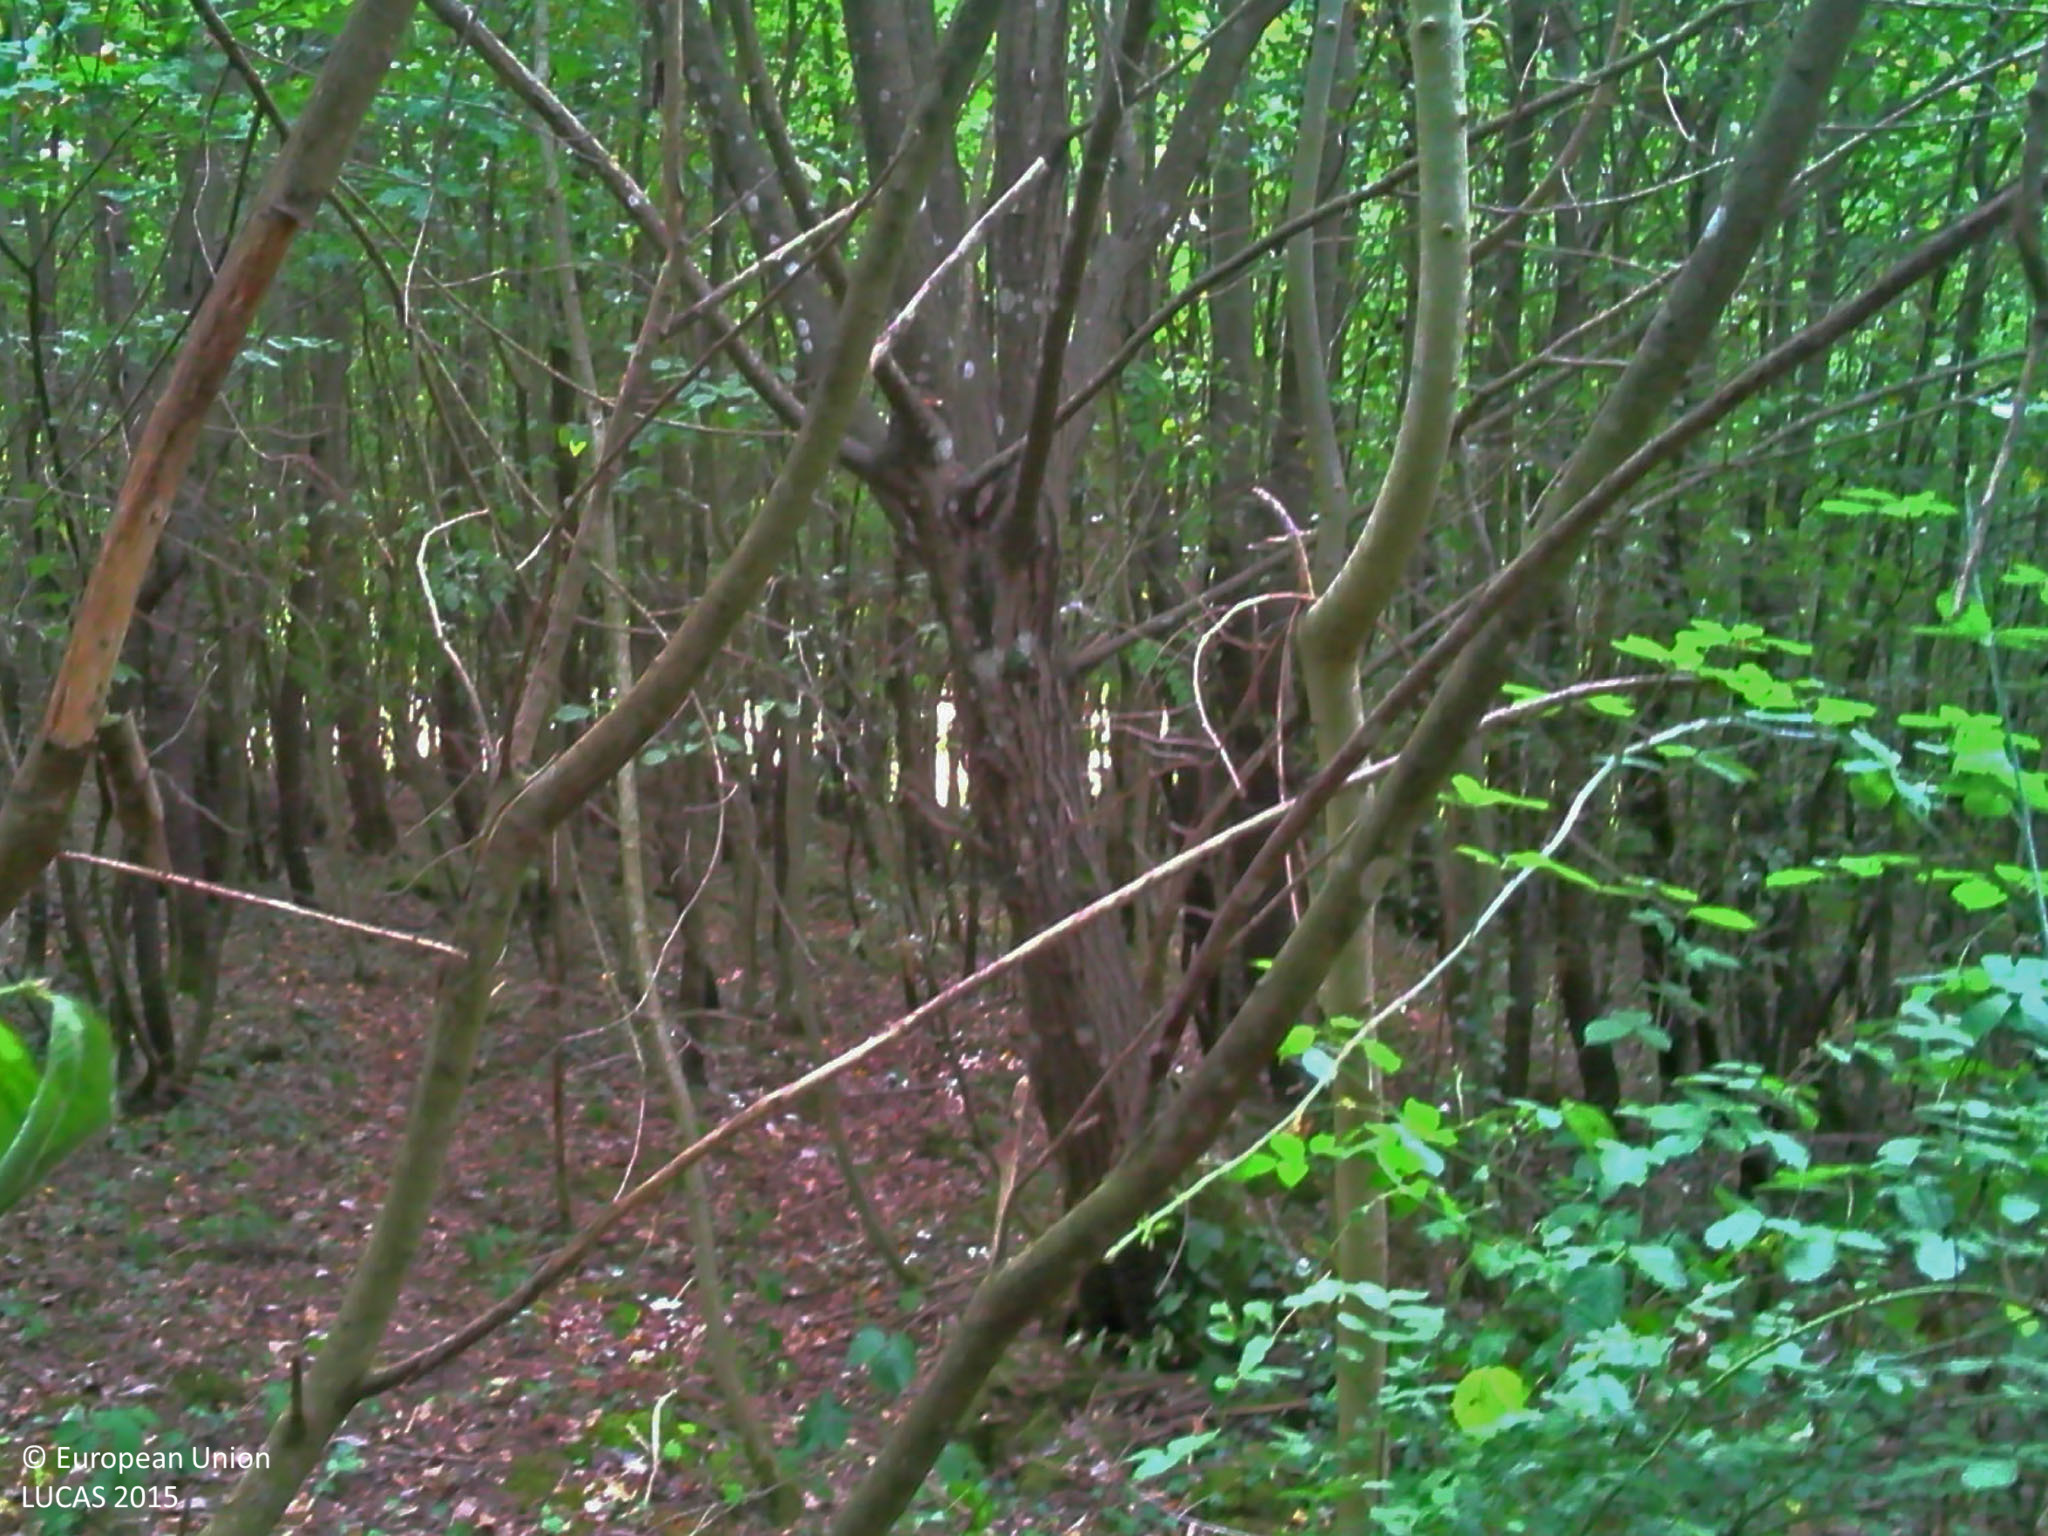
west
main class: Woodland
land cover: Broadleaved woodland
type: beech forest
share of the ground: > 75 %
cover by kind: broadleaved forest trees 50 %, lichens and mosses 20 %, herbaceous plants 10 %, unconsolidated bare surface 10 %
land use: Forestry
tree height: > 5 m
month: August
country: FR
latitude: 48.8860
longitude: 3.2965
